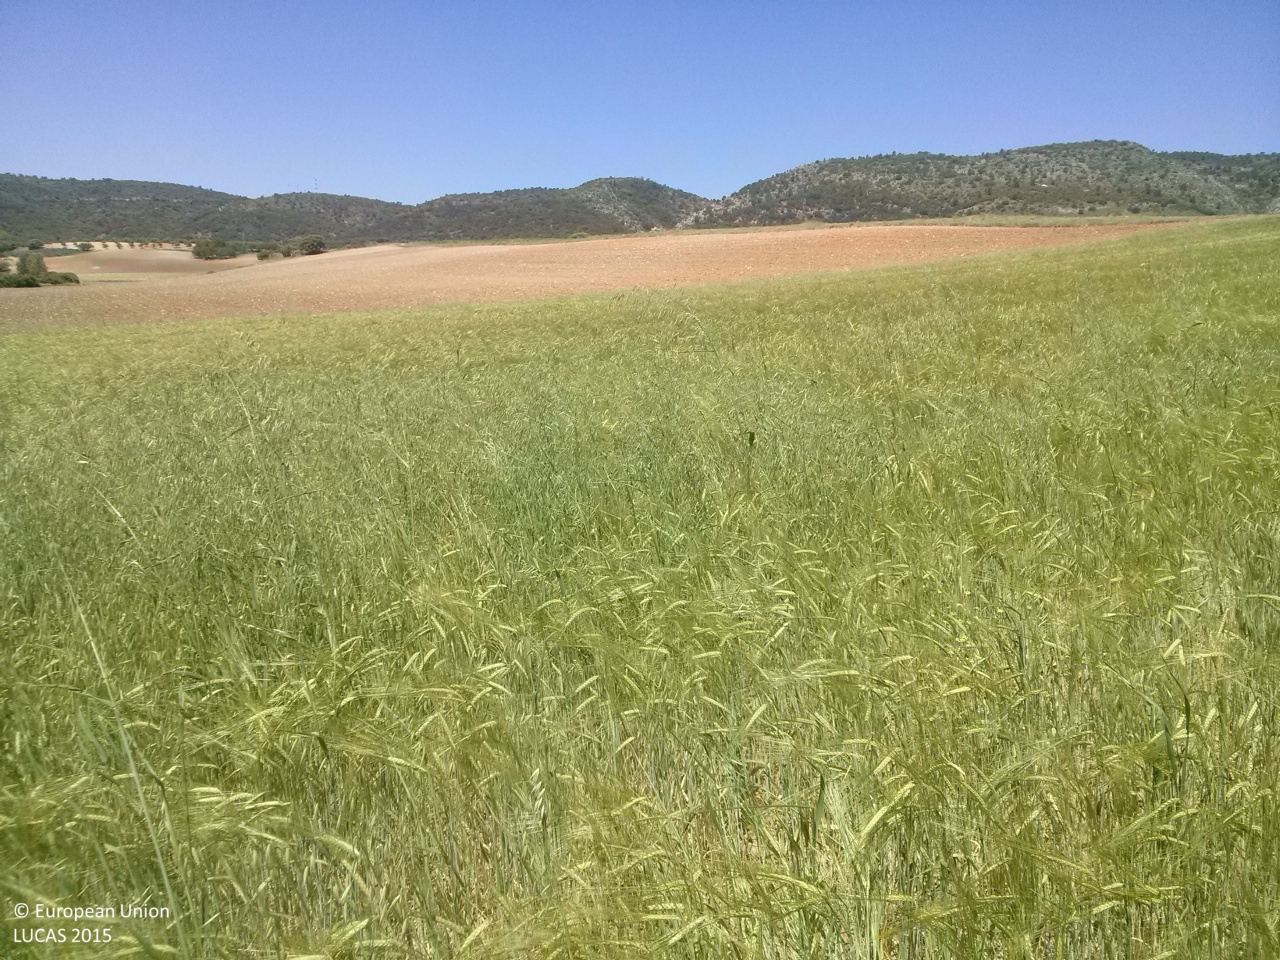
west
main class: Cropland
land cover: Barley
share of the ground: > 75 %
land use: Agriculture (excluding fallow land and kitchen gardens)
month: May
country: ES
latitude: 40.2122
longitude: -2.7960
